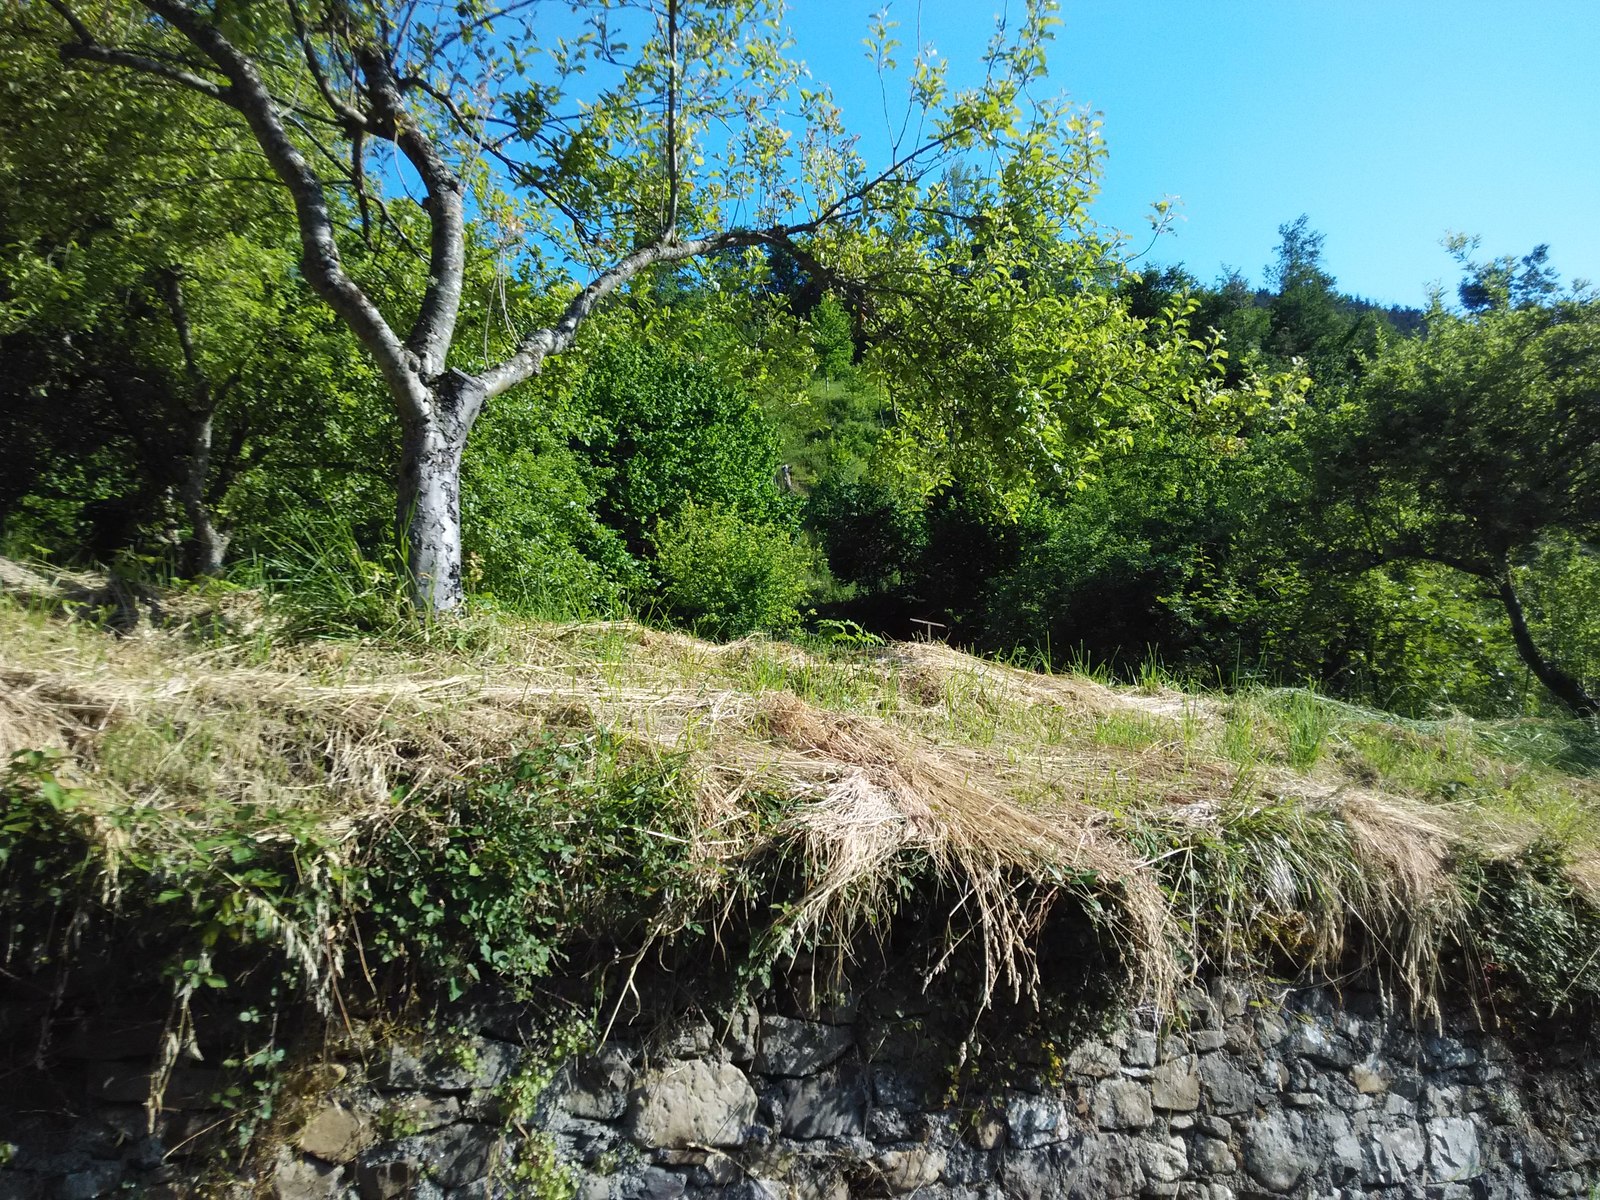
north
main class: Cropland
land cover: Apple fruit
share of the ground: 25 - 50 %
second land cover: Grassland without tree/shrub cover
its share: > 75 %
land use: Agriculture (excluding fallow land and kitchen gardens)
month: June
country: ES
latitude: 43.0547
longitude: -2.5628
